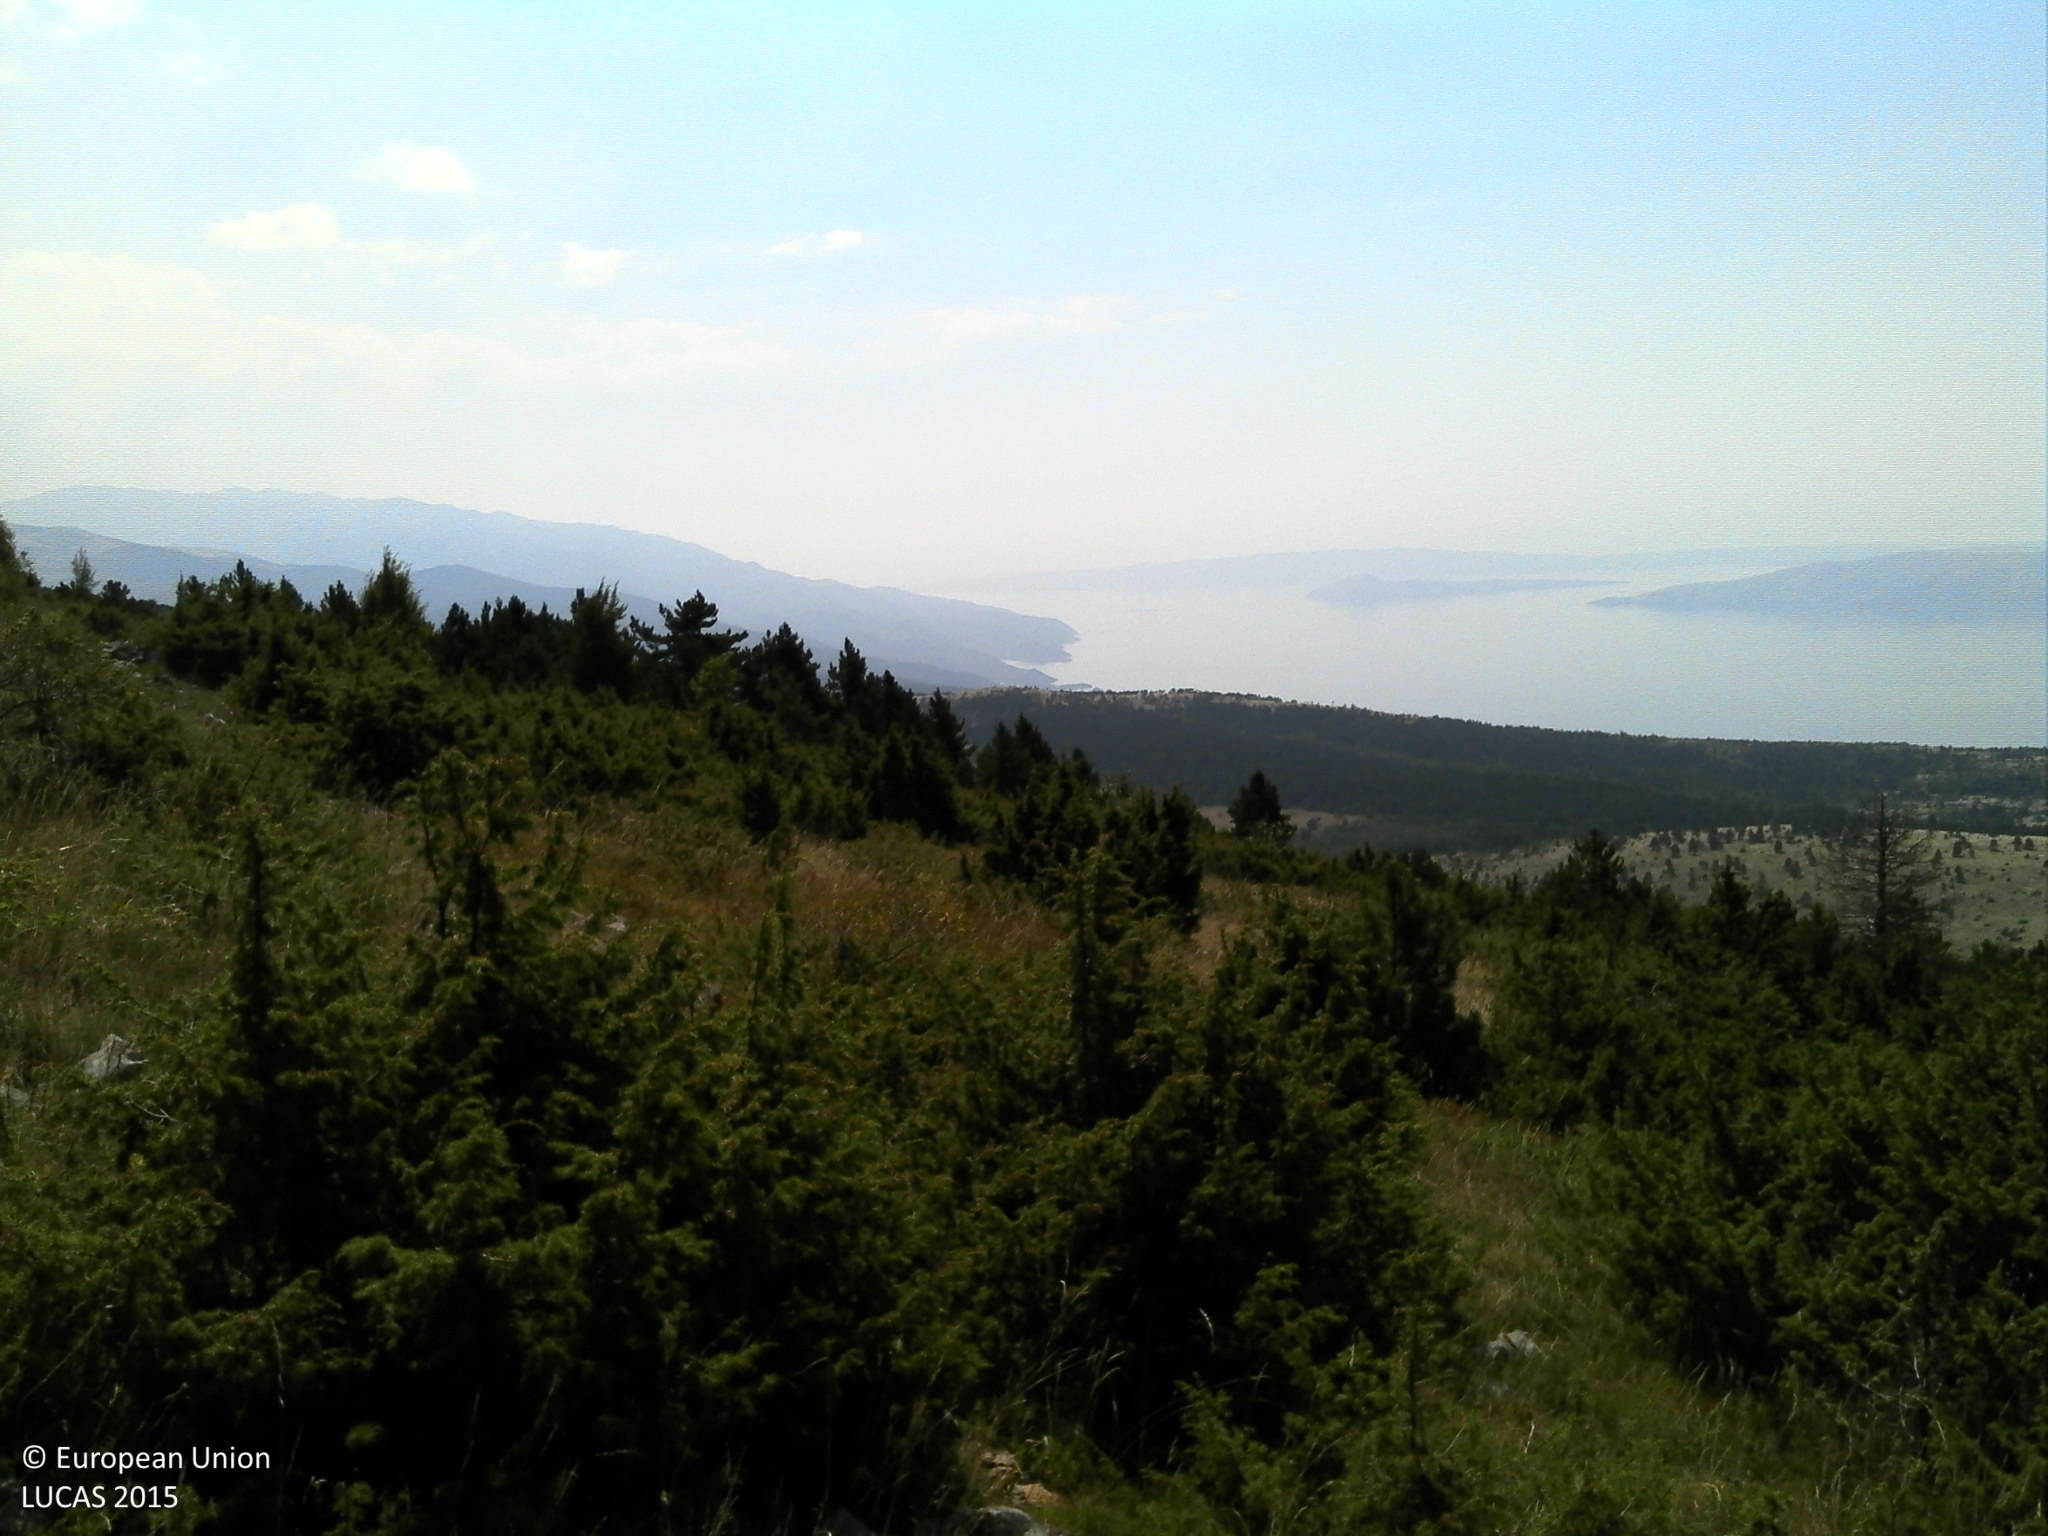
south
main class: Shrubland
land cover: Shrubland with sparse tree cover
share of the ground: > 75 %
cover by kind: shrubs 65 %, herbaceous plants 20 %, coniferous forest trees 5 %, consolidated bare surface 5 %, unconsolidated bare surface 5 %
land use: Semi-natural and natural areas not in use
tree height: < 5 m
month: August
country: HR
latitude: 45.0089
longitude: 14.9553
